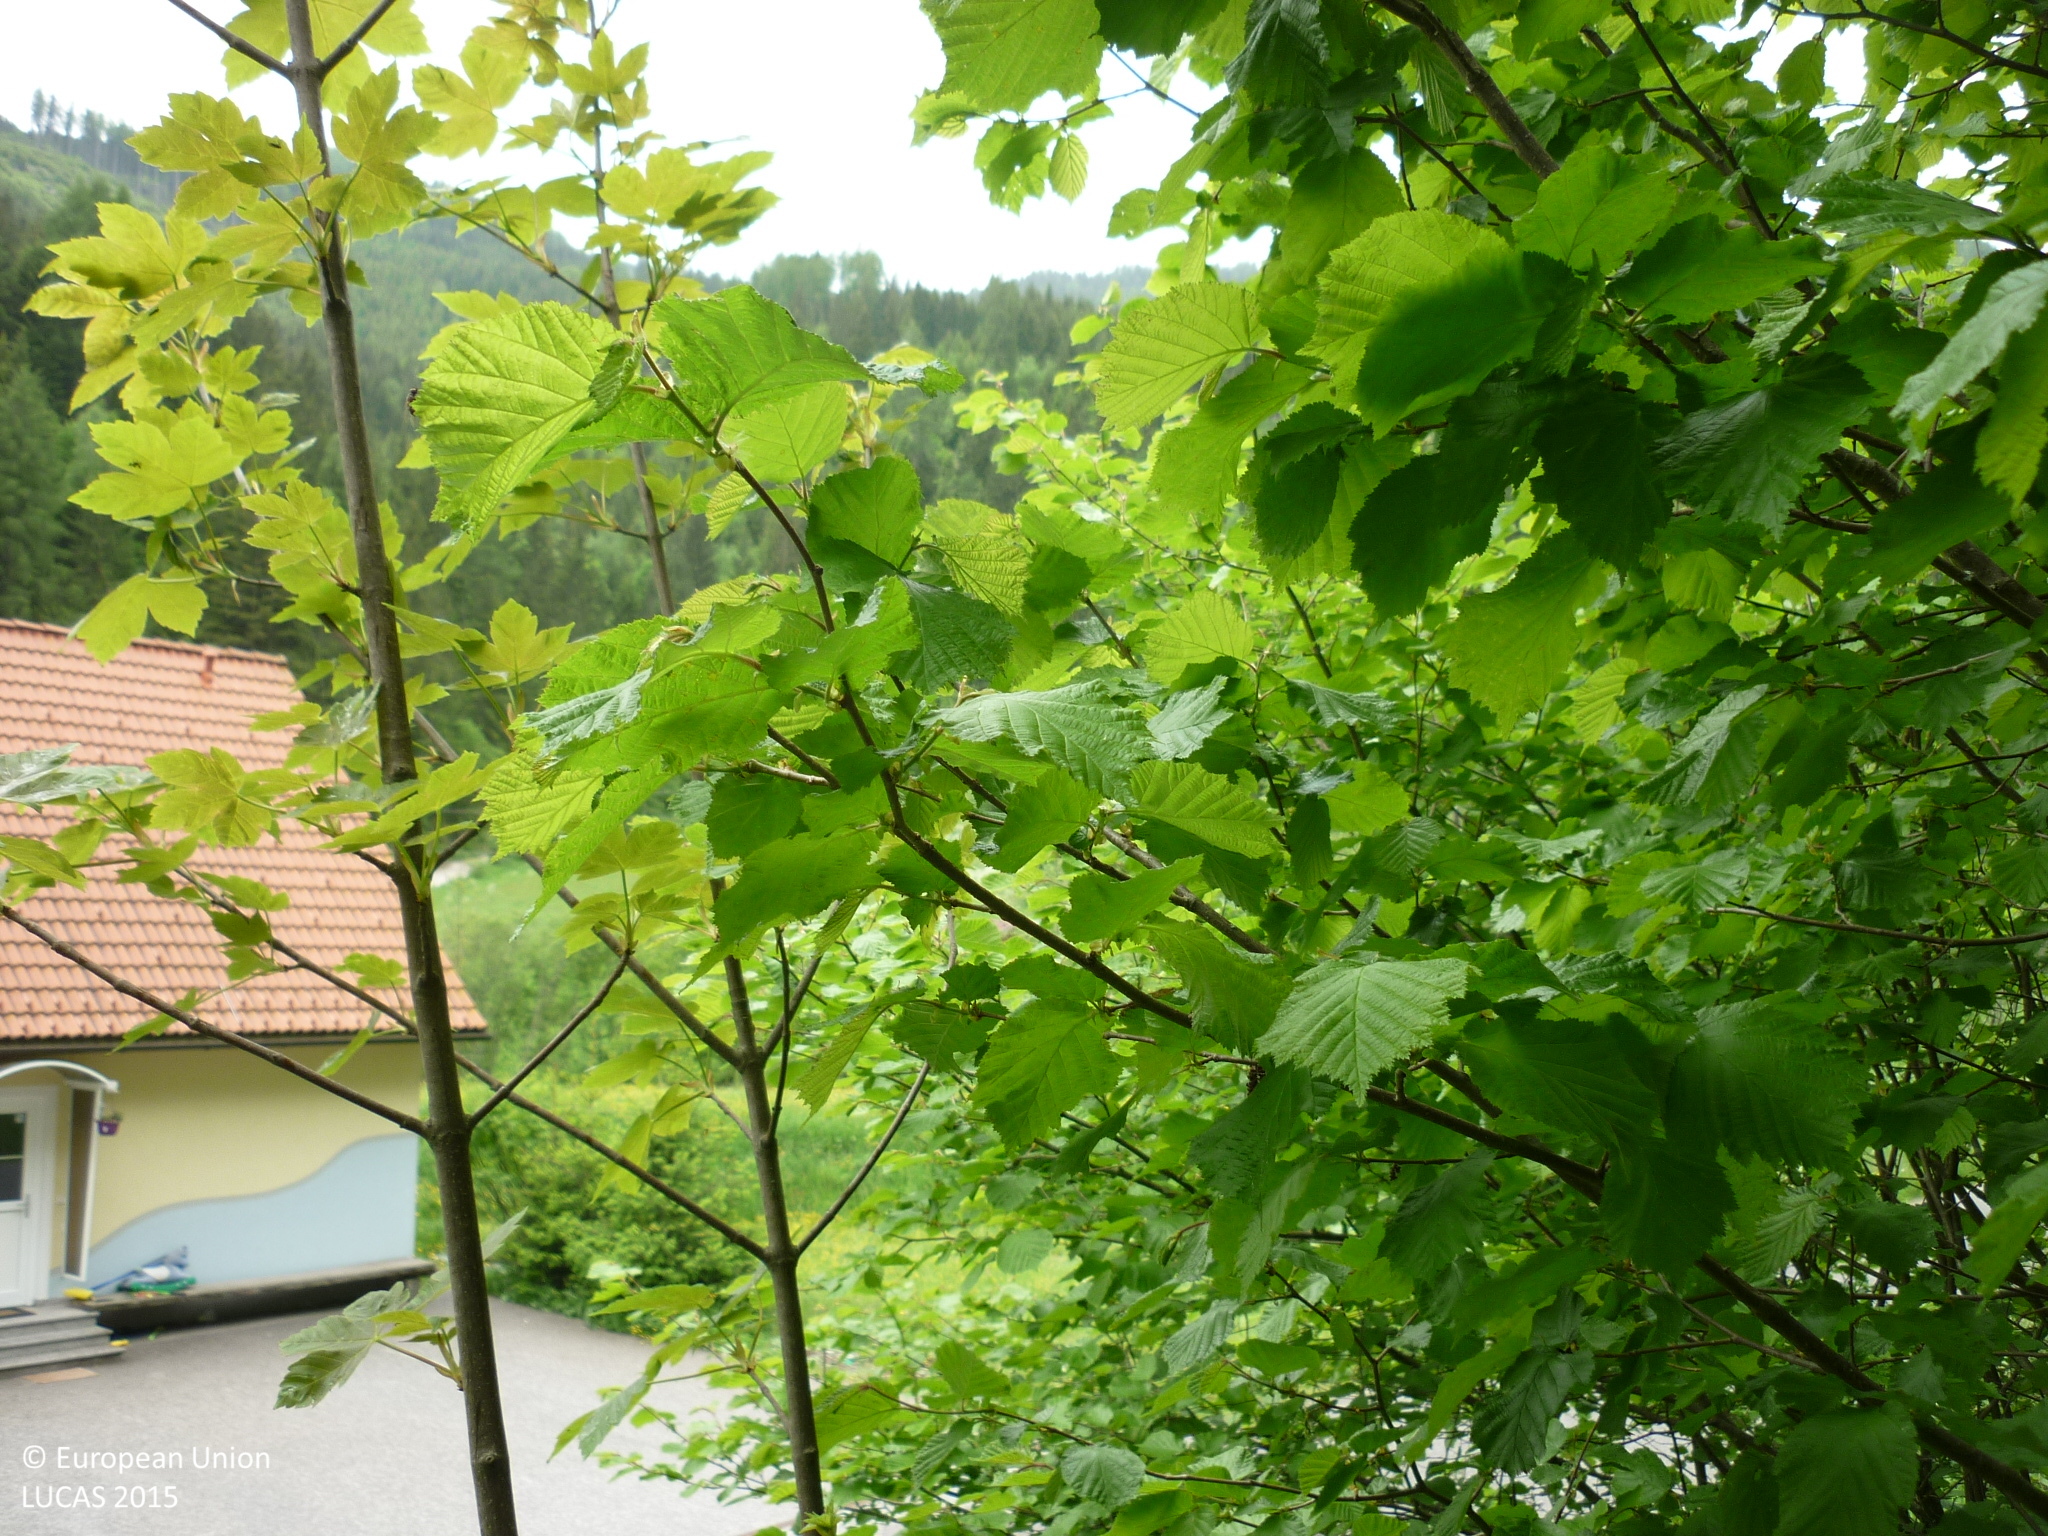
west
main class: Shrubland
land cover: Shrubland with sparse tree cover
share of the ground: 50 - 75 %
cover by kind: shrubs 50 %, herbaceous plants 25 %, consolidated bare surface 10 %, unconsolidated bare surface 10 %, coniferous forest trees 5 %
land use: Semi-natural and natural areas not in use
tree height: > 5 m
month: June
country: AT
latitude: 47.3234
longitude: 14.4312
